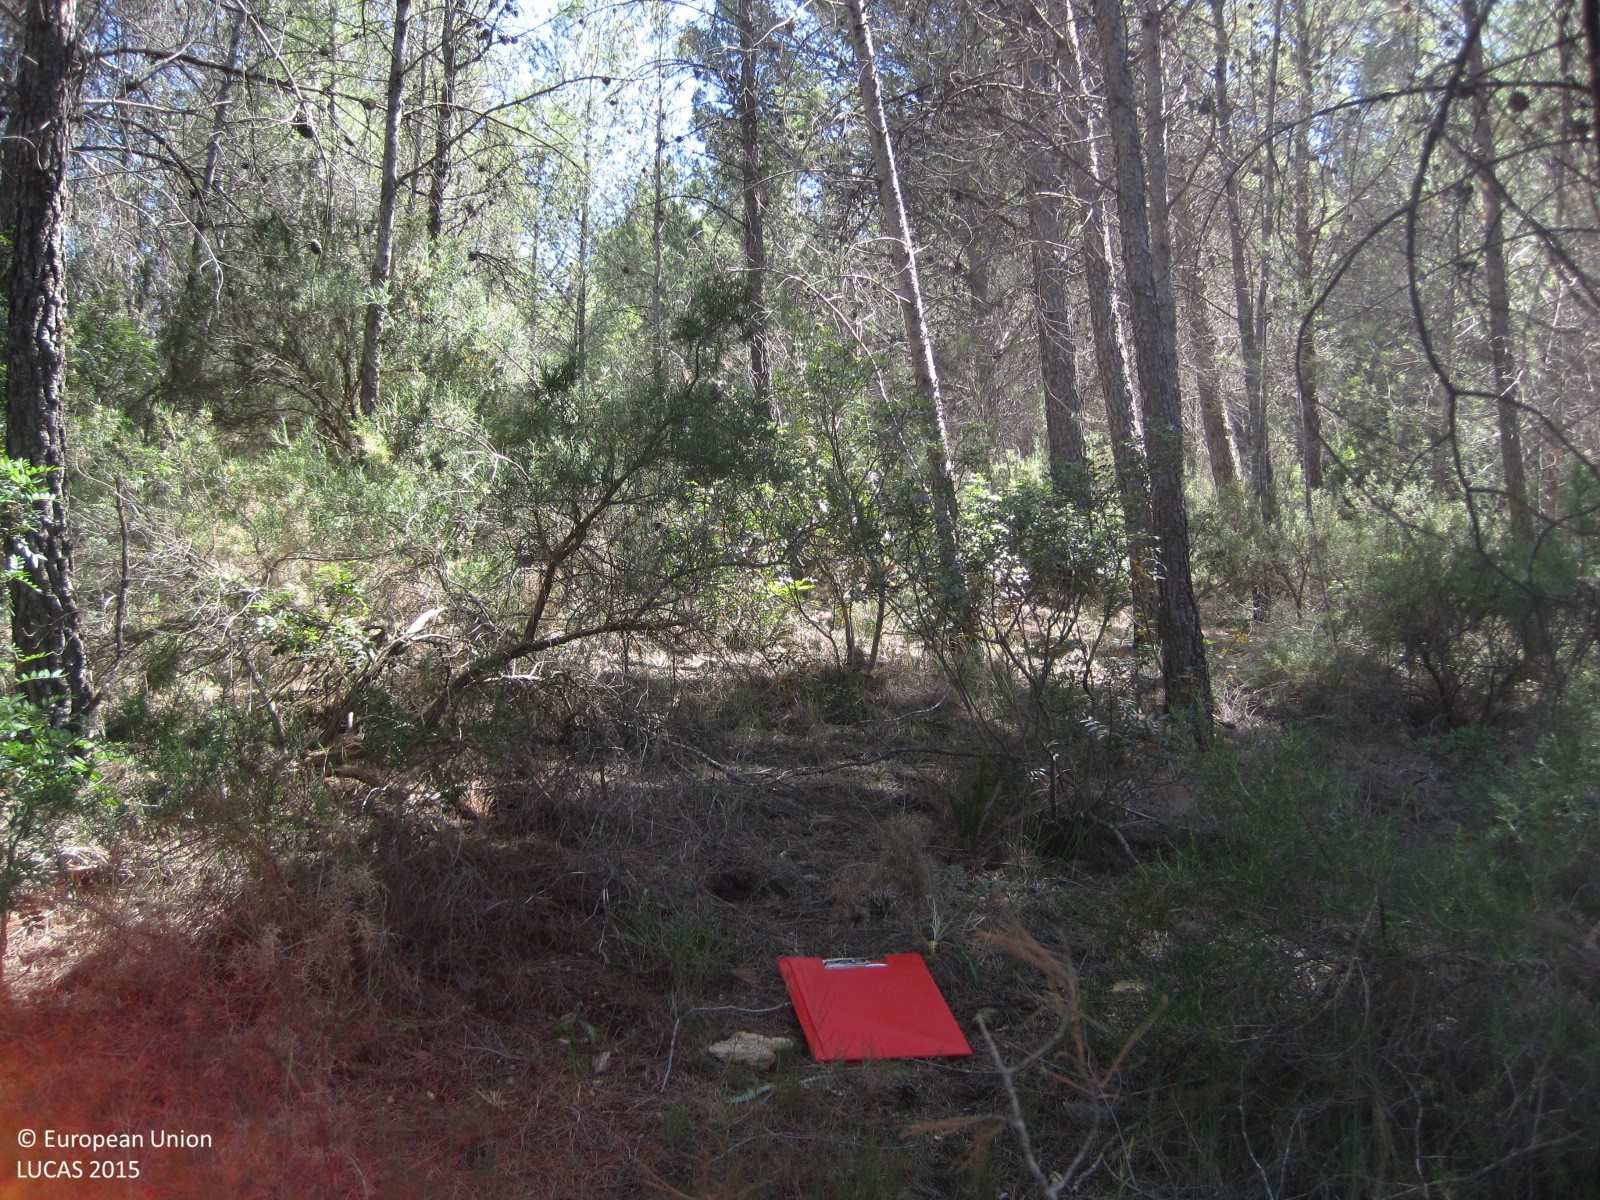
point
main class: Woodland
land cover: Pine dominated coniferous woodland
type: coniferous forest of the mediterranean region
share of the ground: > 75 %
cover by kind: coniferous forest trees 90 %, shrubs 10 %
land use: Semi-natural and natural areas not in use
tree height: > 5 m
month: May
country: ES
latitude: 39.3716
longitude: -0.8517
